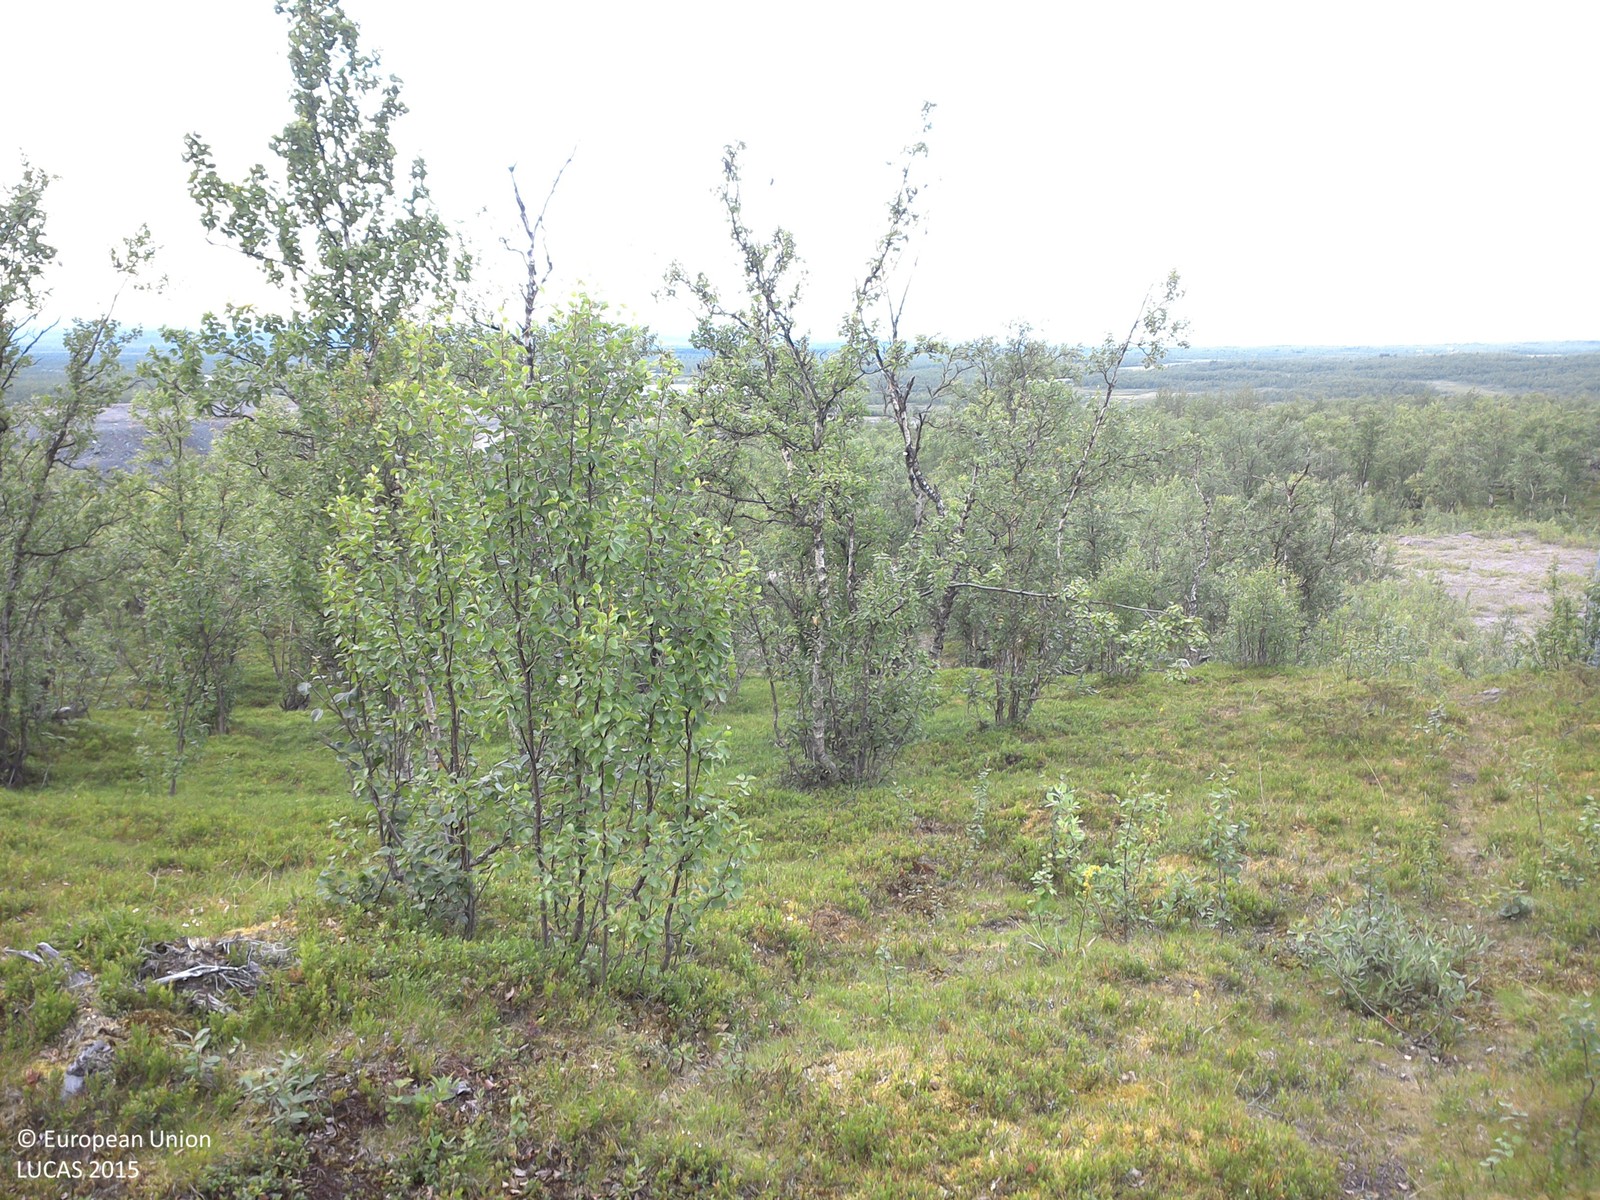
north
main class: Woodland
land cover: Broadleaved woodland
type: boreal forest
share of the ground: 10 - 25 %
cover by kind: shrubs 80 %, broadleaved forest trees 20 %
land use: Mining and quarrying
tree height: > 5 m
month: August
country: SE
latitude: 67.8728
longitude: 20.1446
